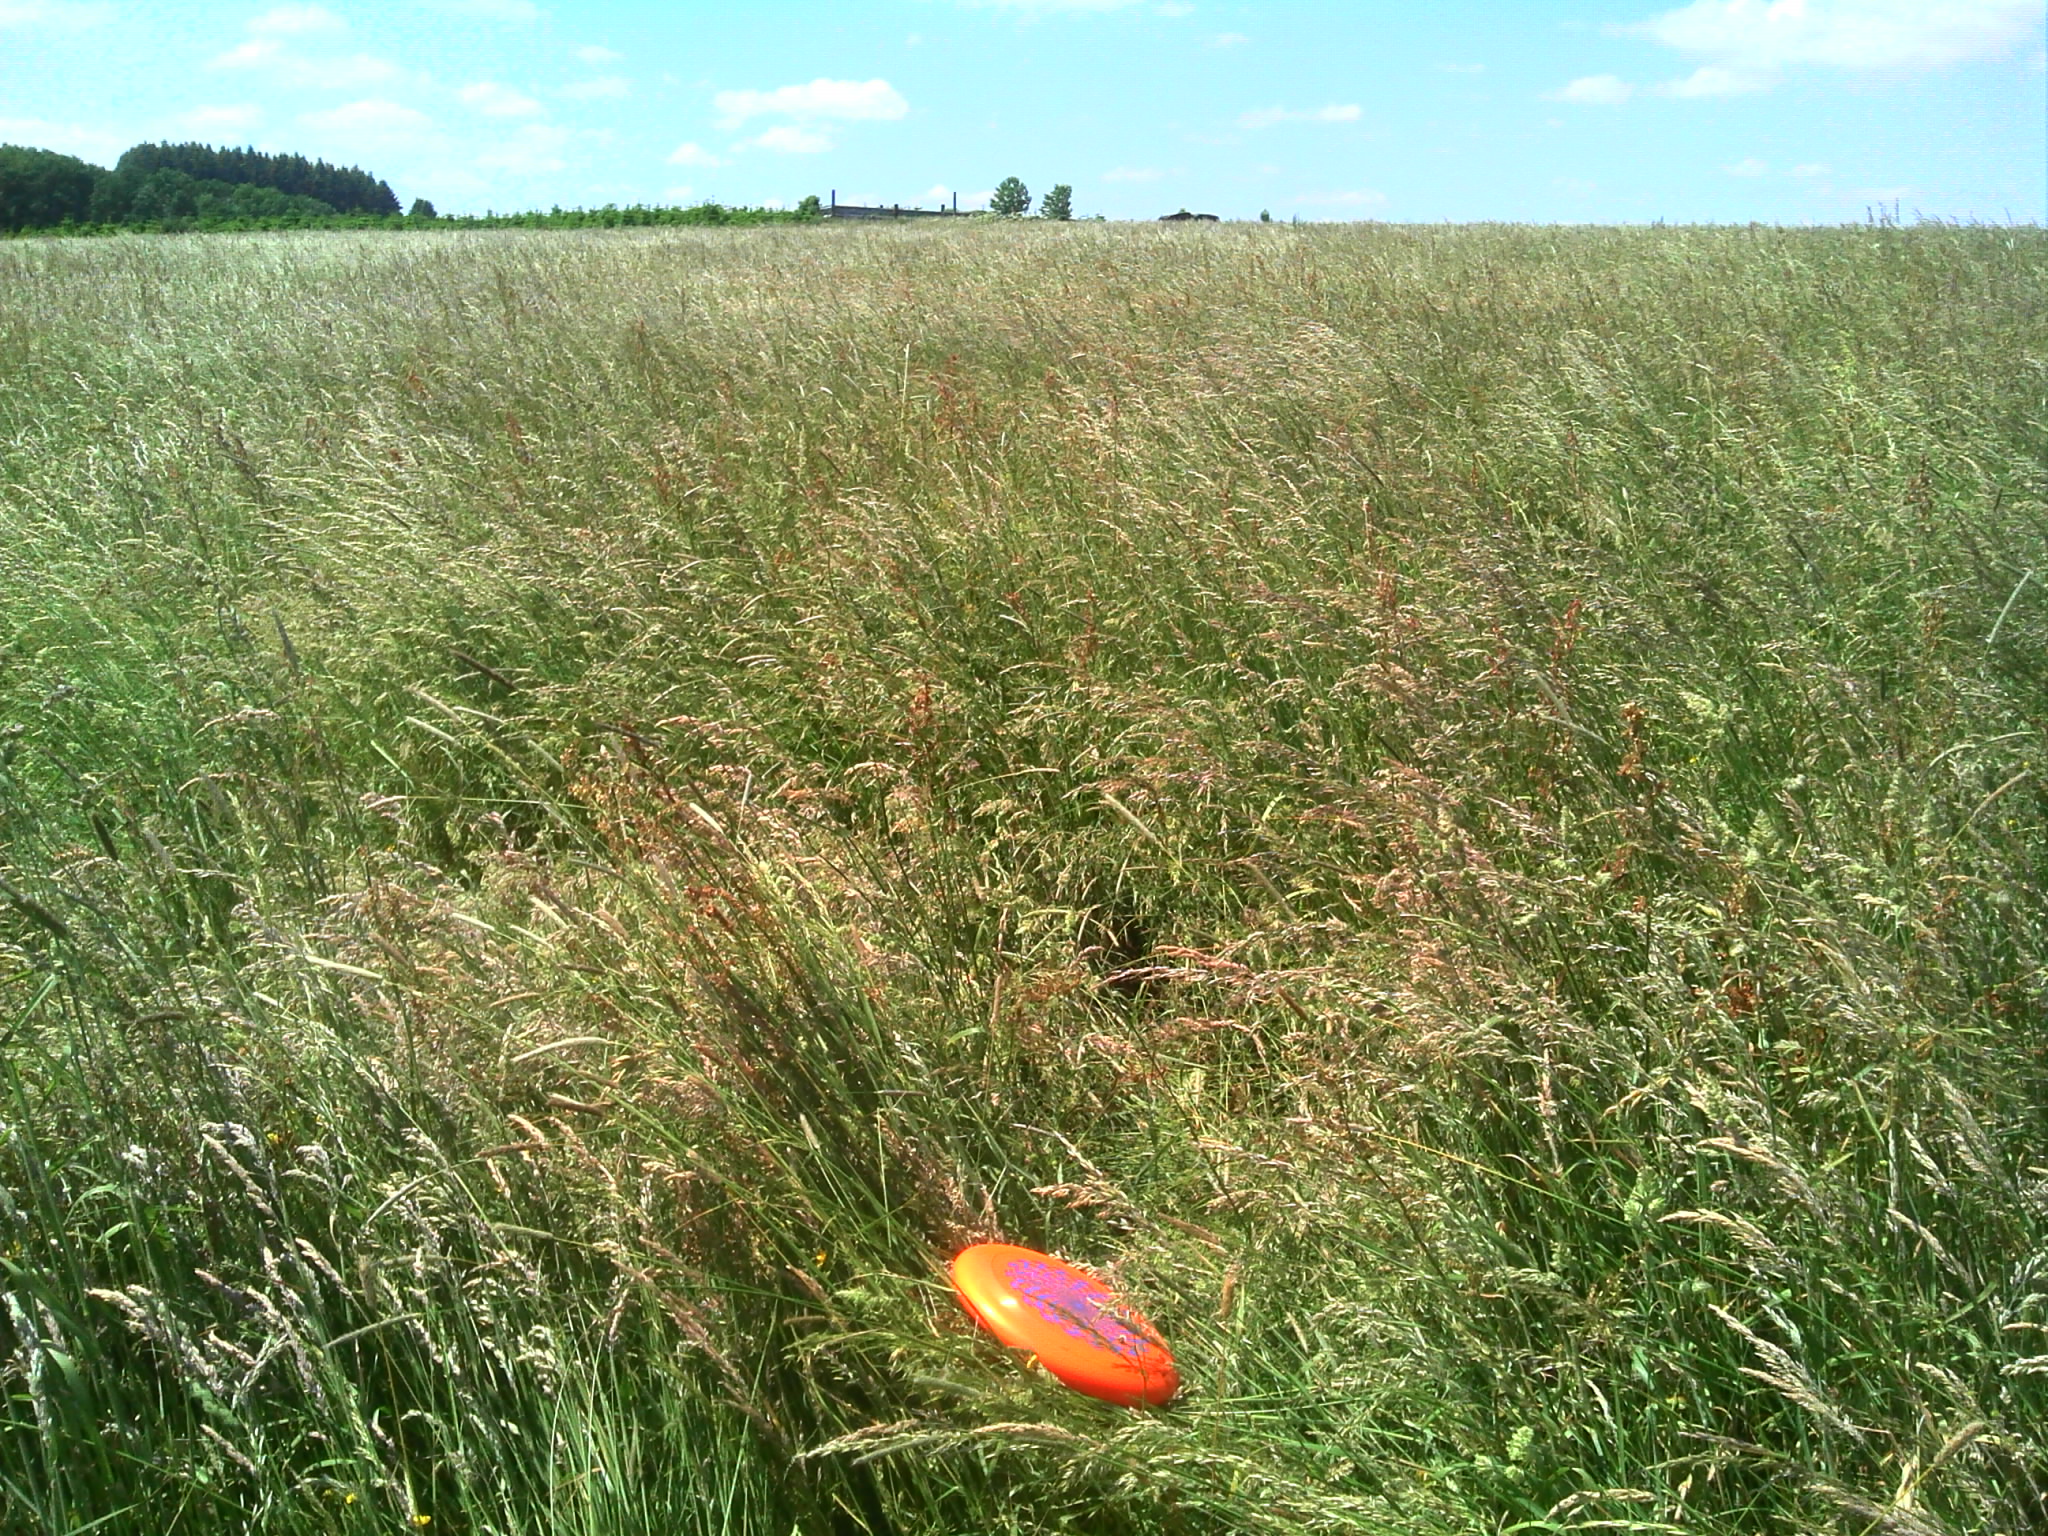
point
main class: Grassland
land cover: Grassland without tree/shrub cover
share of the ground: > 75 %
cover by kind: herbaceous plants 100 %
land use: Agriculture (excluding fallow land and kitchen gardens)
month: June
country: BE
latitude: 50.2651
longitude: 5.2420
